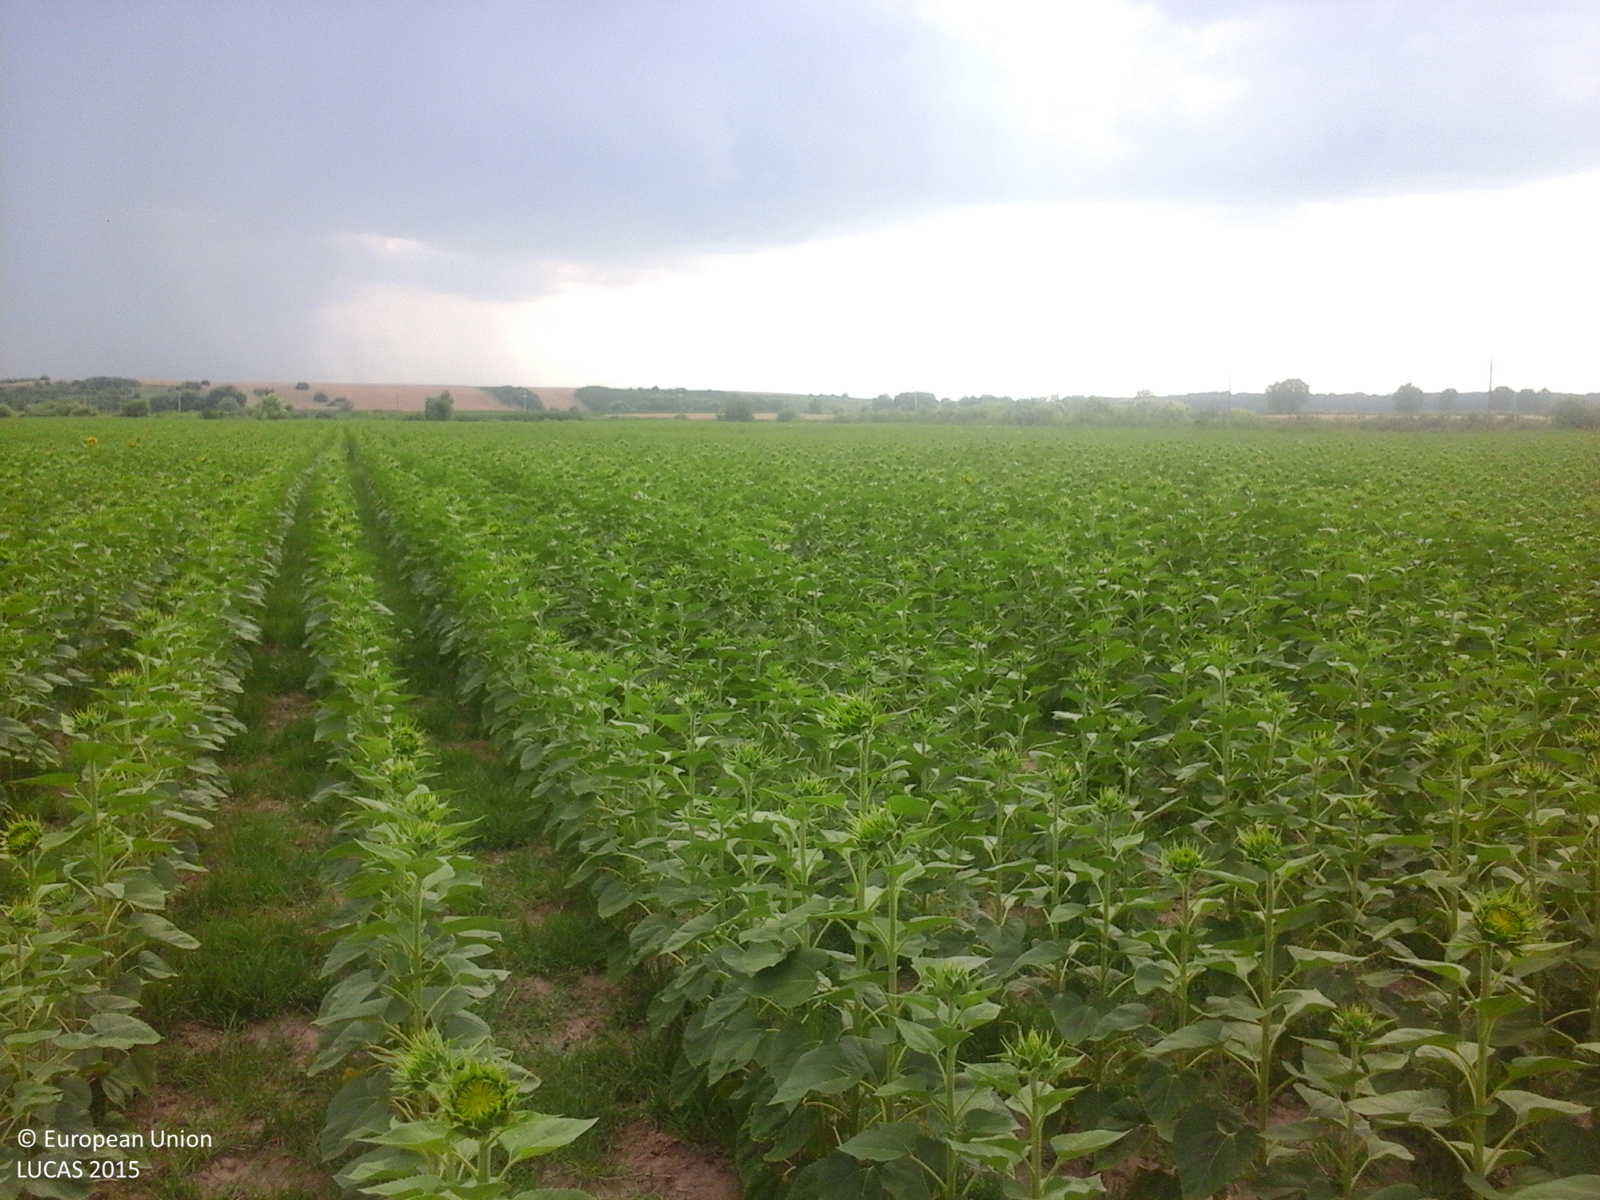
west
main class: Cropland
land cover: Sunflower
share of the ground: > 75 %
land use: Agriculture (excluding fallow land and kitchen gardens)
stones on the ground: < 10 %
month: June
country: RO
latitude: 44.2292
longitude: 25.9358
